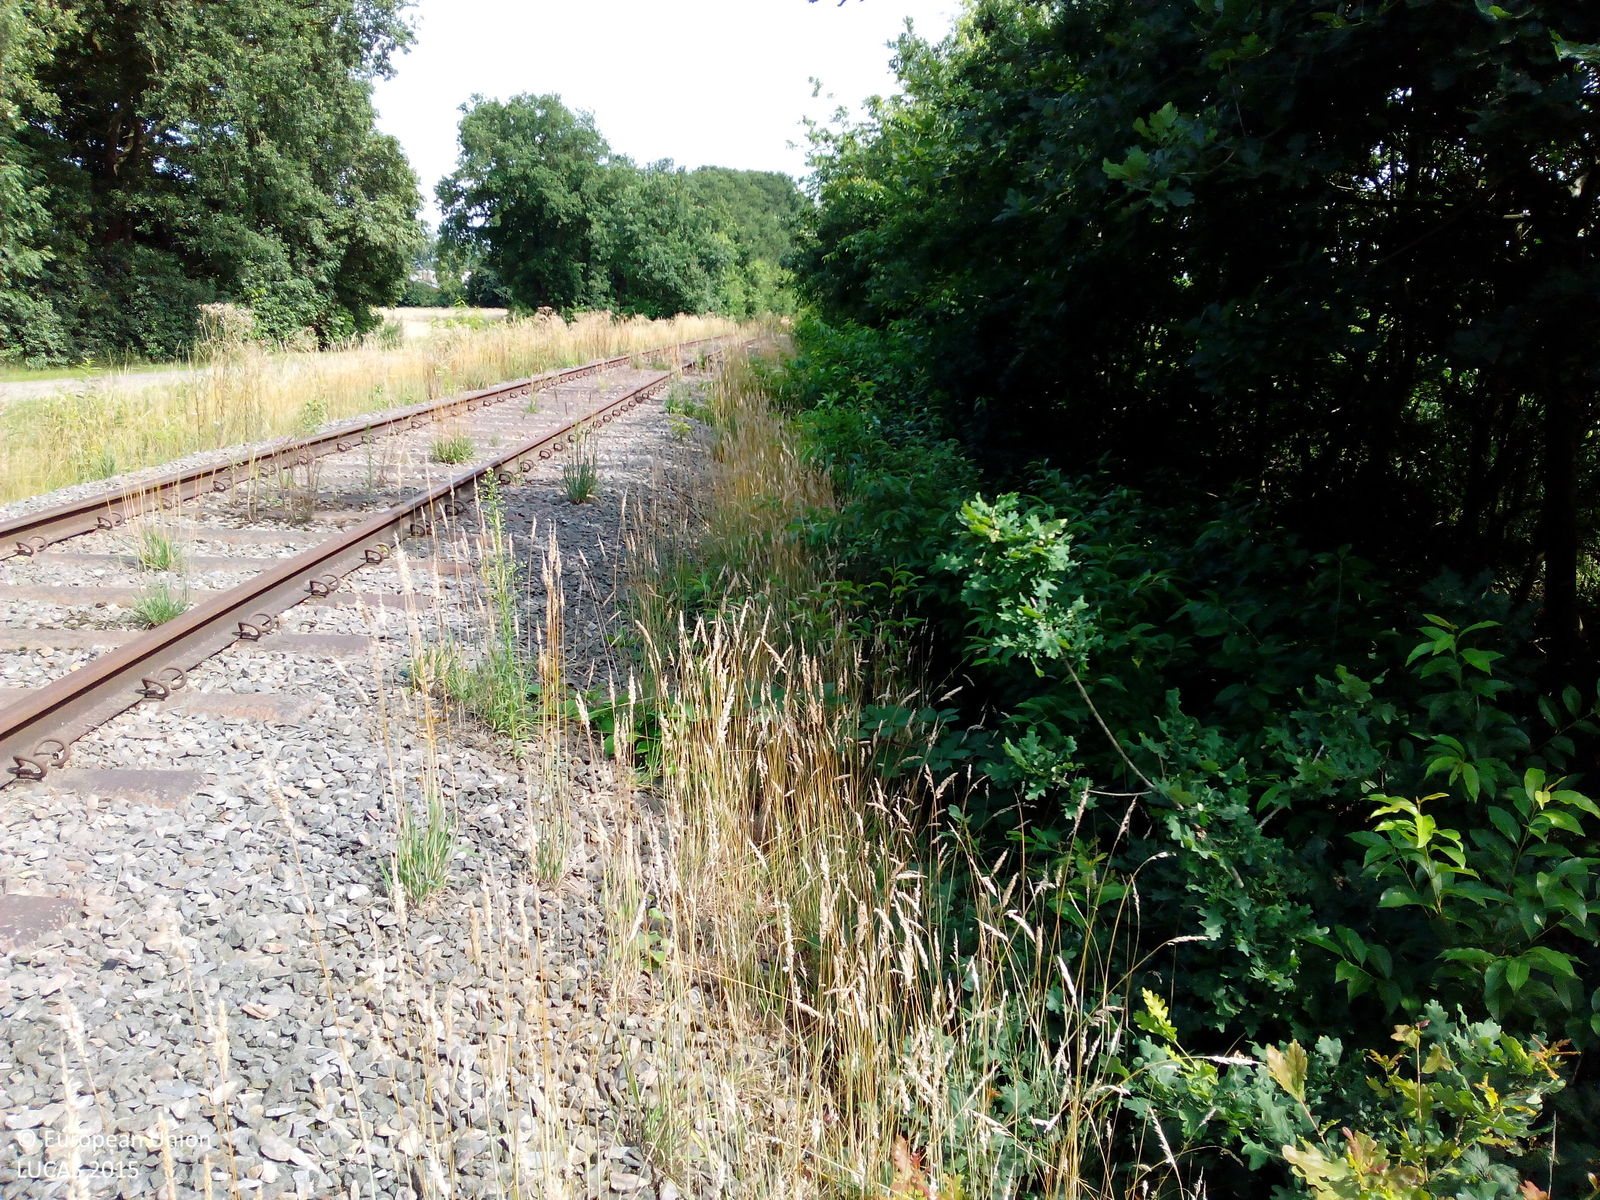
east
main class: Cropland
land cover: Maize
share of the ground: > 75 %
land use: Agriculture (excluding fallow land and kitchen gardens)
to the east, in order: Maize; Broadleaved woodland; Railways; Broadleaved woodland; Paved roads, cycling and walking lanes; Broadleaved woodland; Artificial constructions in urban areas
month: July
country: DE
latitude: 53.0067
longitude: 7.9291
